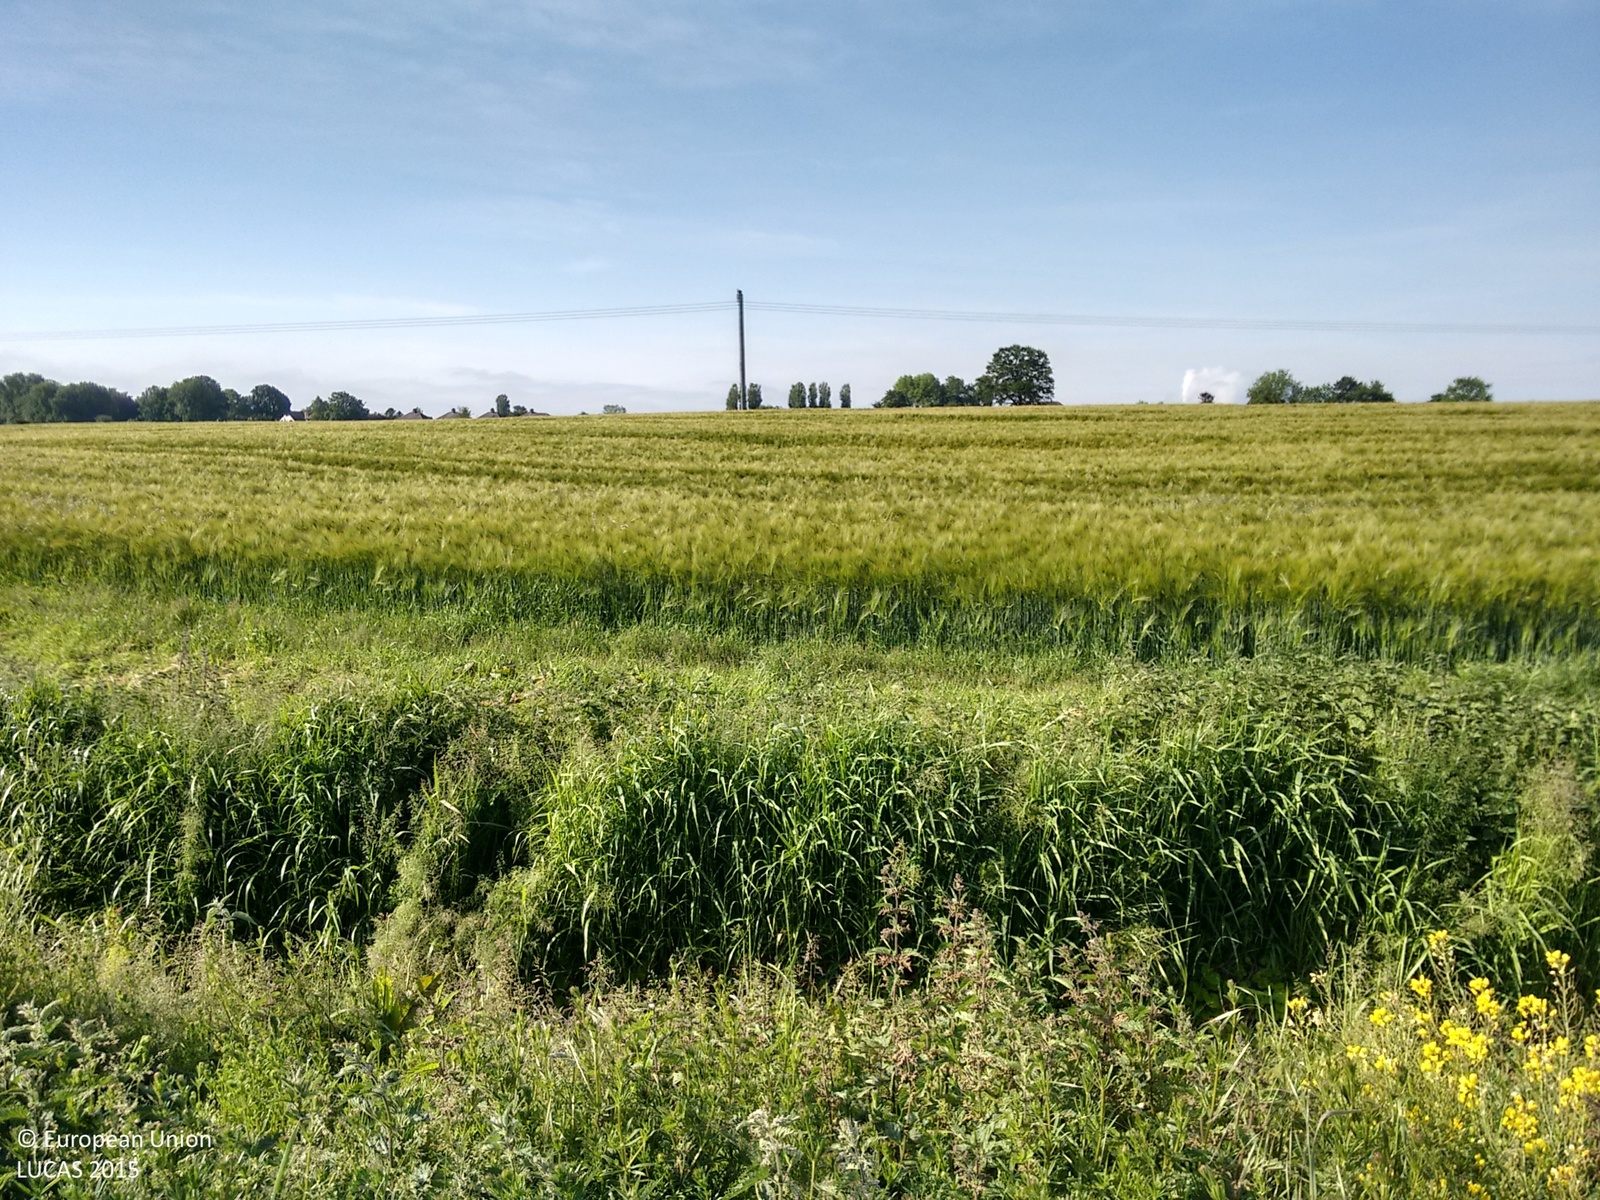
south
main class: Cropland
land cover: Common wheat
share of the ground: > 75 %
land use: Agriculture (excluding fallow land and kitchen gardens)
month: June
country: GB
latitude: 53.7993
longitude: -1.0818
